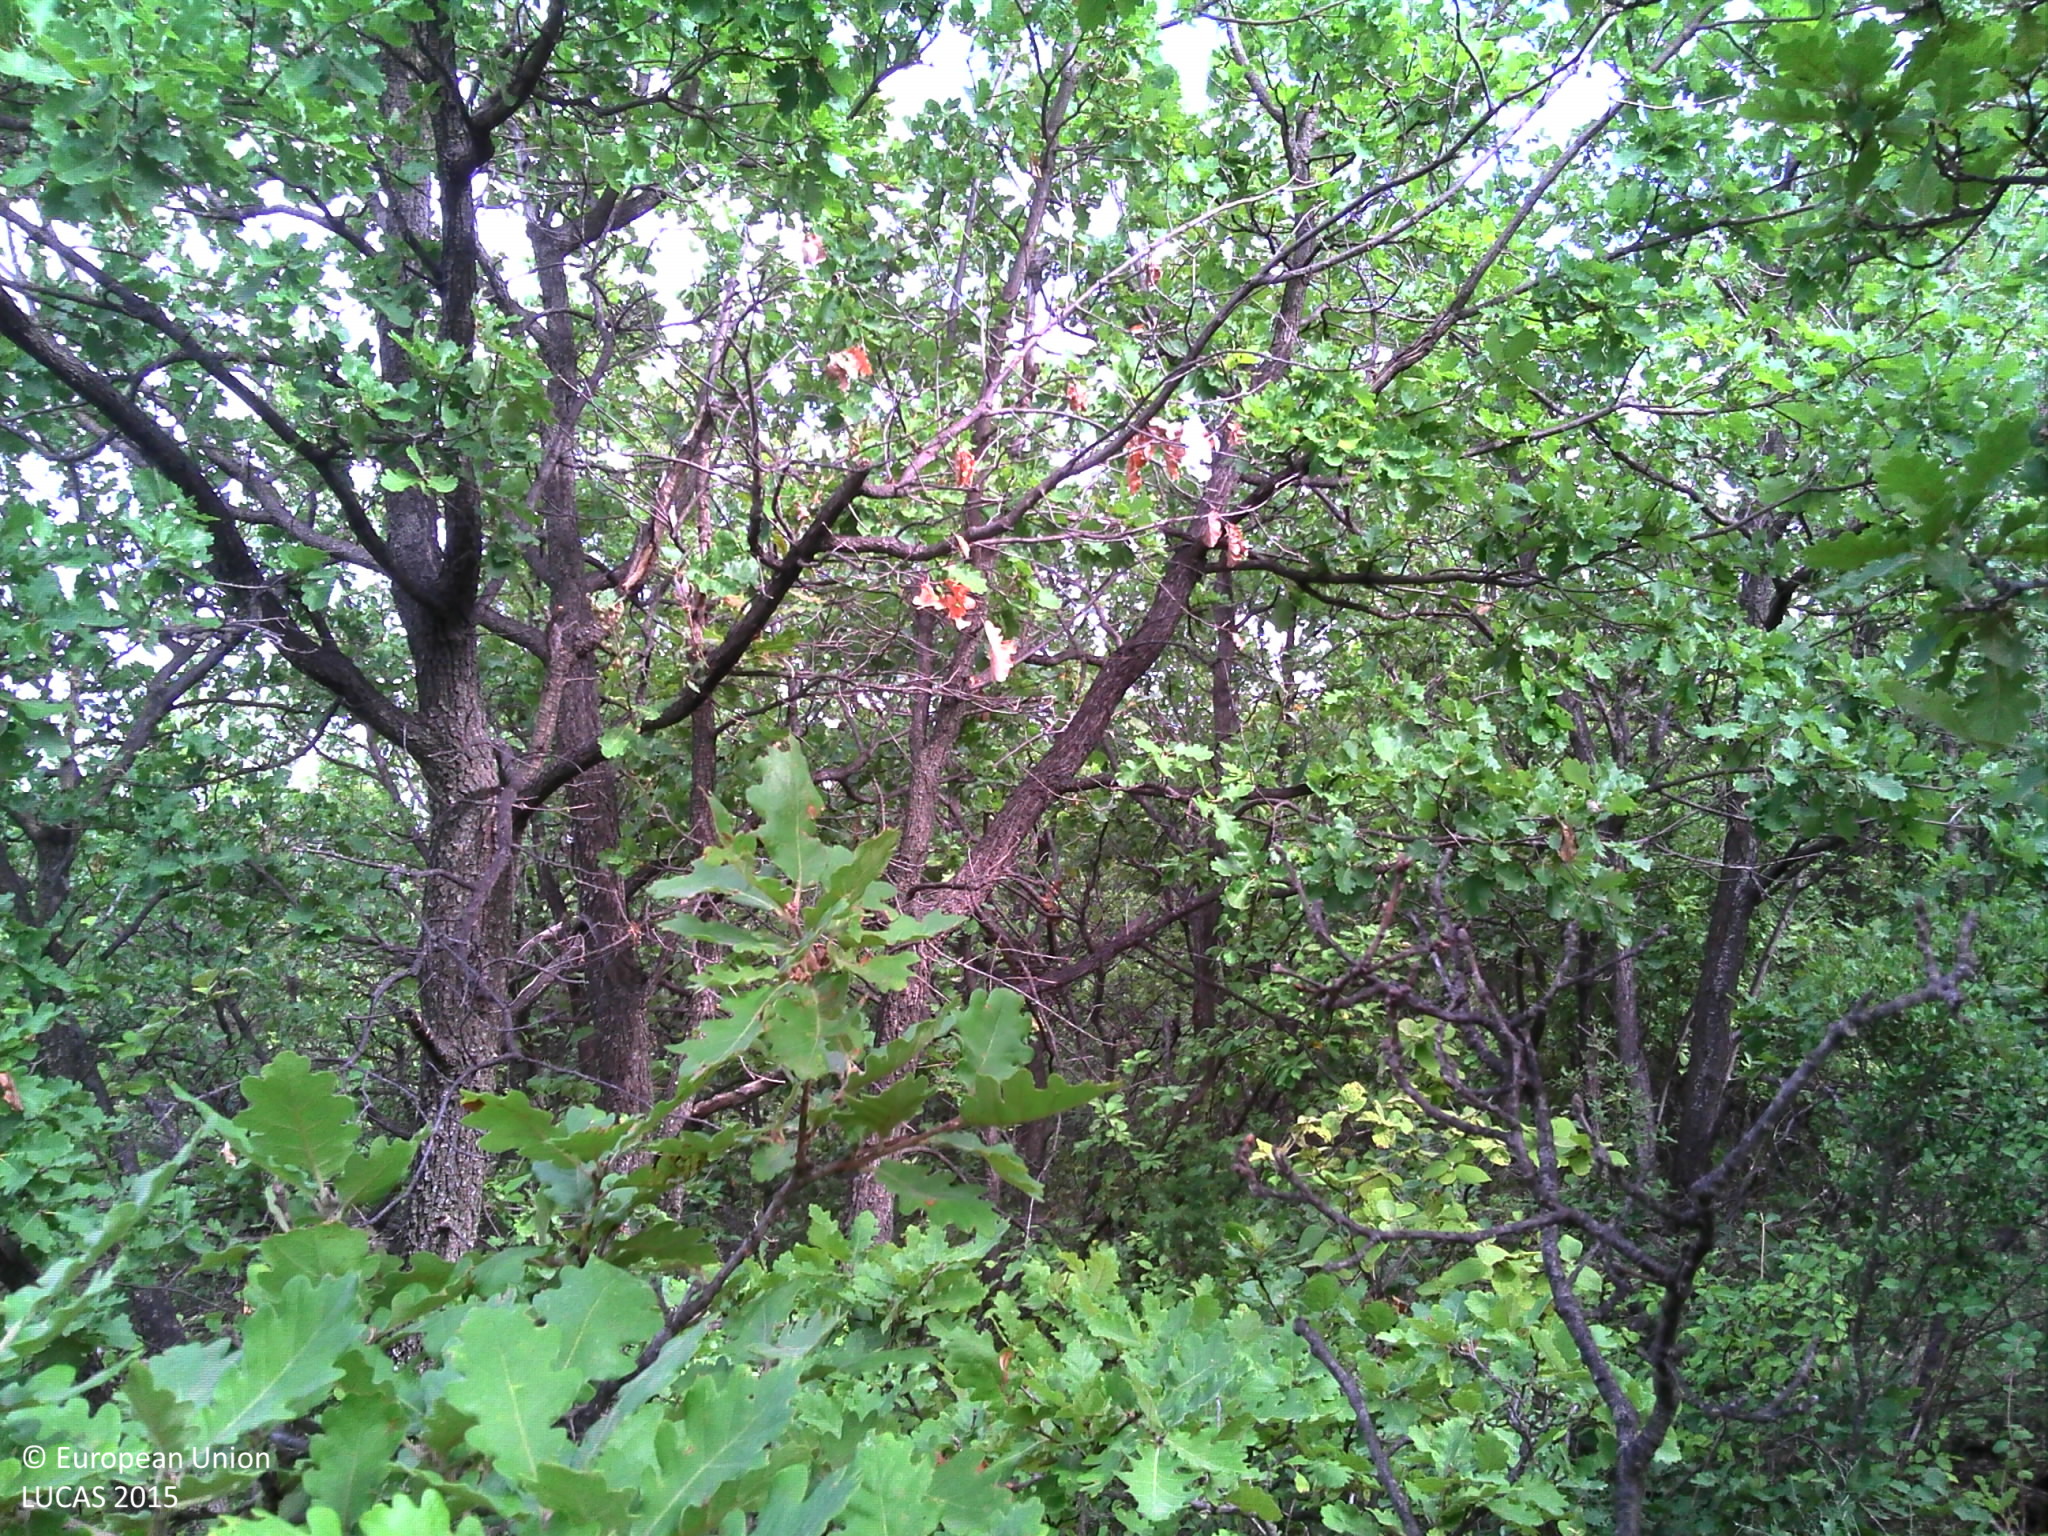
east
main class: Woodland
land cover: Pine dominated mixed woodland
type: coniferous forest of the mediterranean region
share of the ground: > 75 %
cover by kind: broadleaved forest trees 55 %, coniferous forest trees 25 %, shrubs 10 %, herbaceous plants 10 %
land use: Forestry
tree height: > 5 m
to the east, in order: Pine dominated mixed woodland; Paved roads, cycling and walking lanes; Broadleaved woodland; Other bare soil; Broadleaved woodland
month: September
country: FR
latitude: 44.3398
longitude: 5.0280
